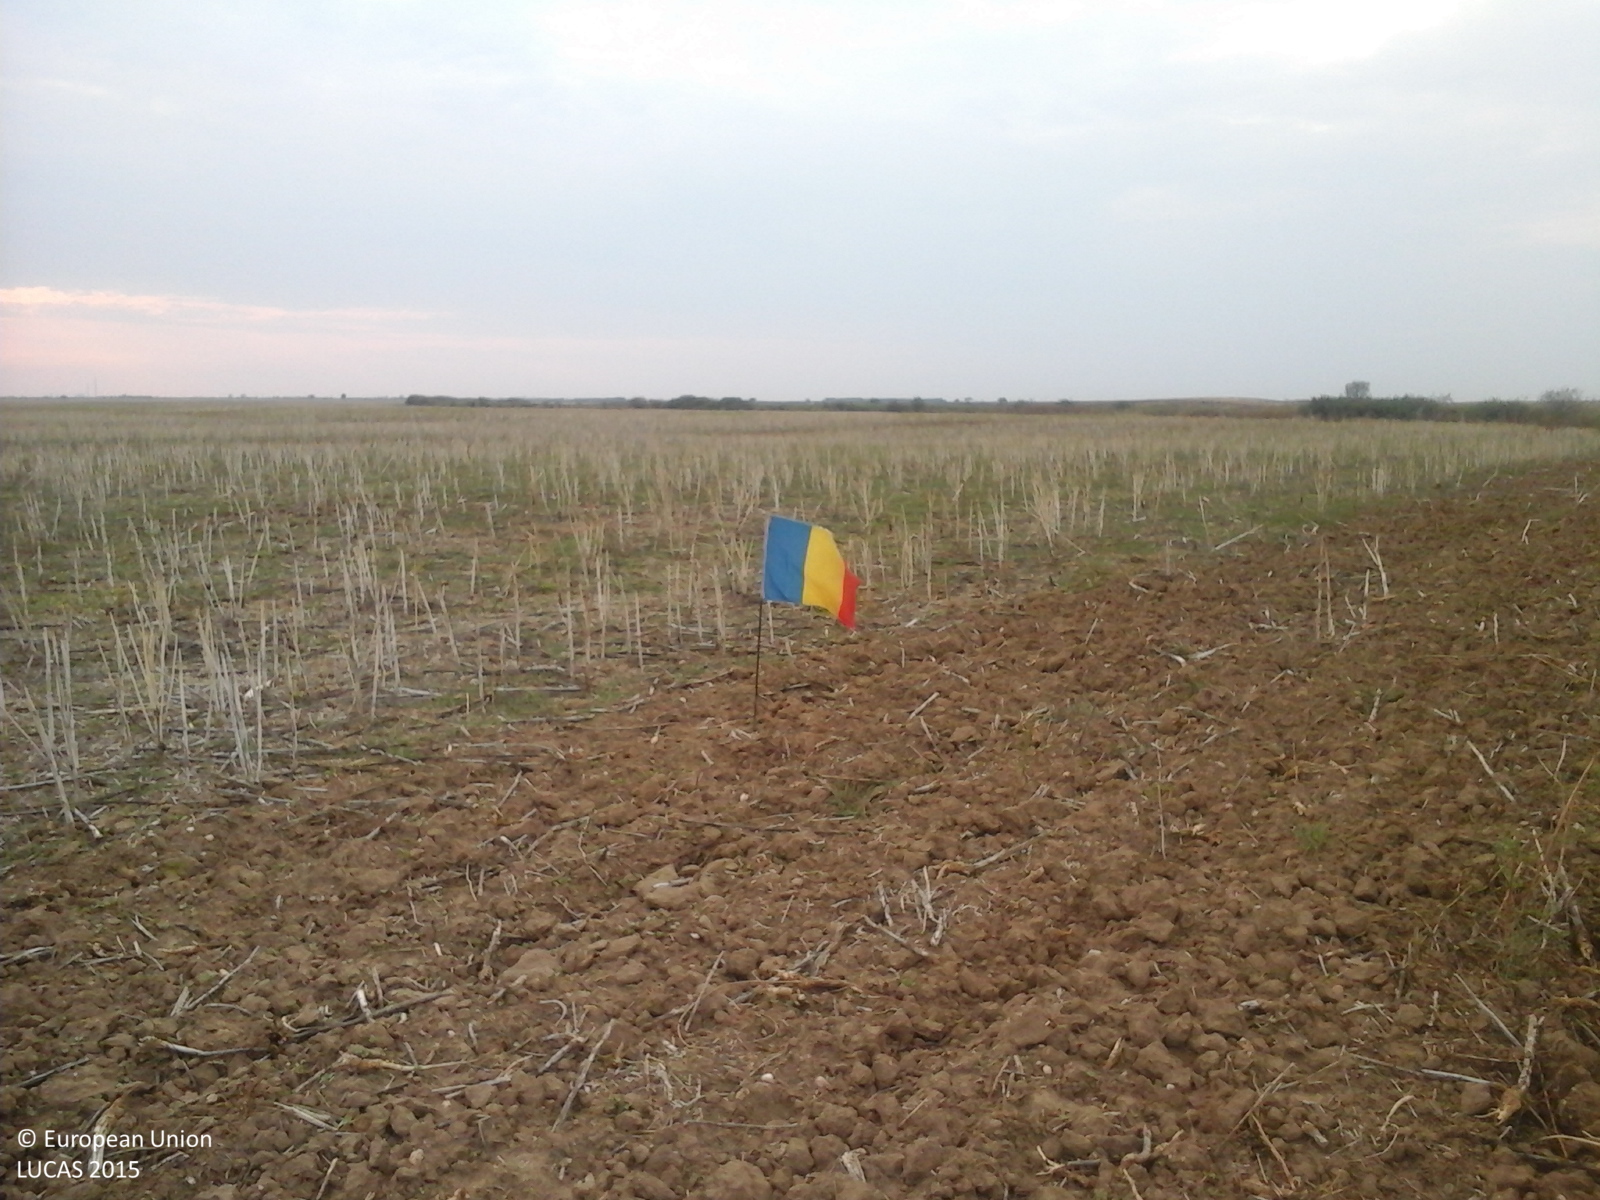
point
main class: Cropland
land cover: Rape and turnip rape
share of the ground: < 10 %
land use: Agriculture (excluding fallow land and kitchen gardens)
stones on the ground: < 10 %
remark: Harvested field
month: August
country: RO
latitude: 46.1804
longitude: 21.5272
